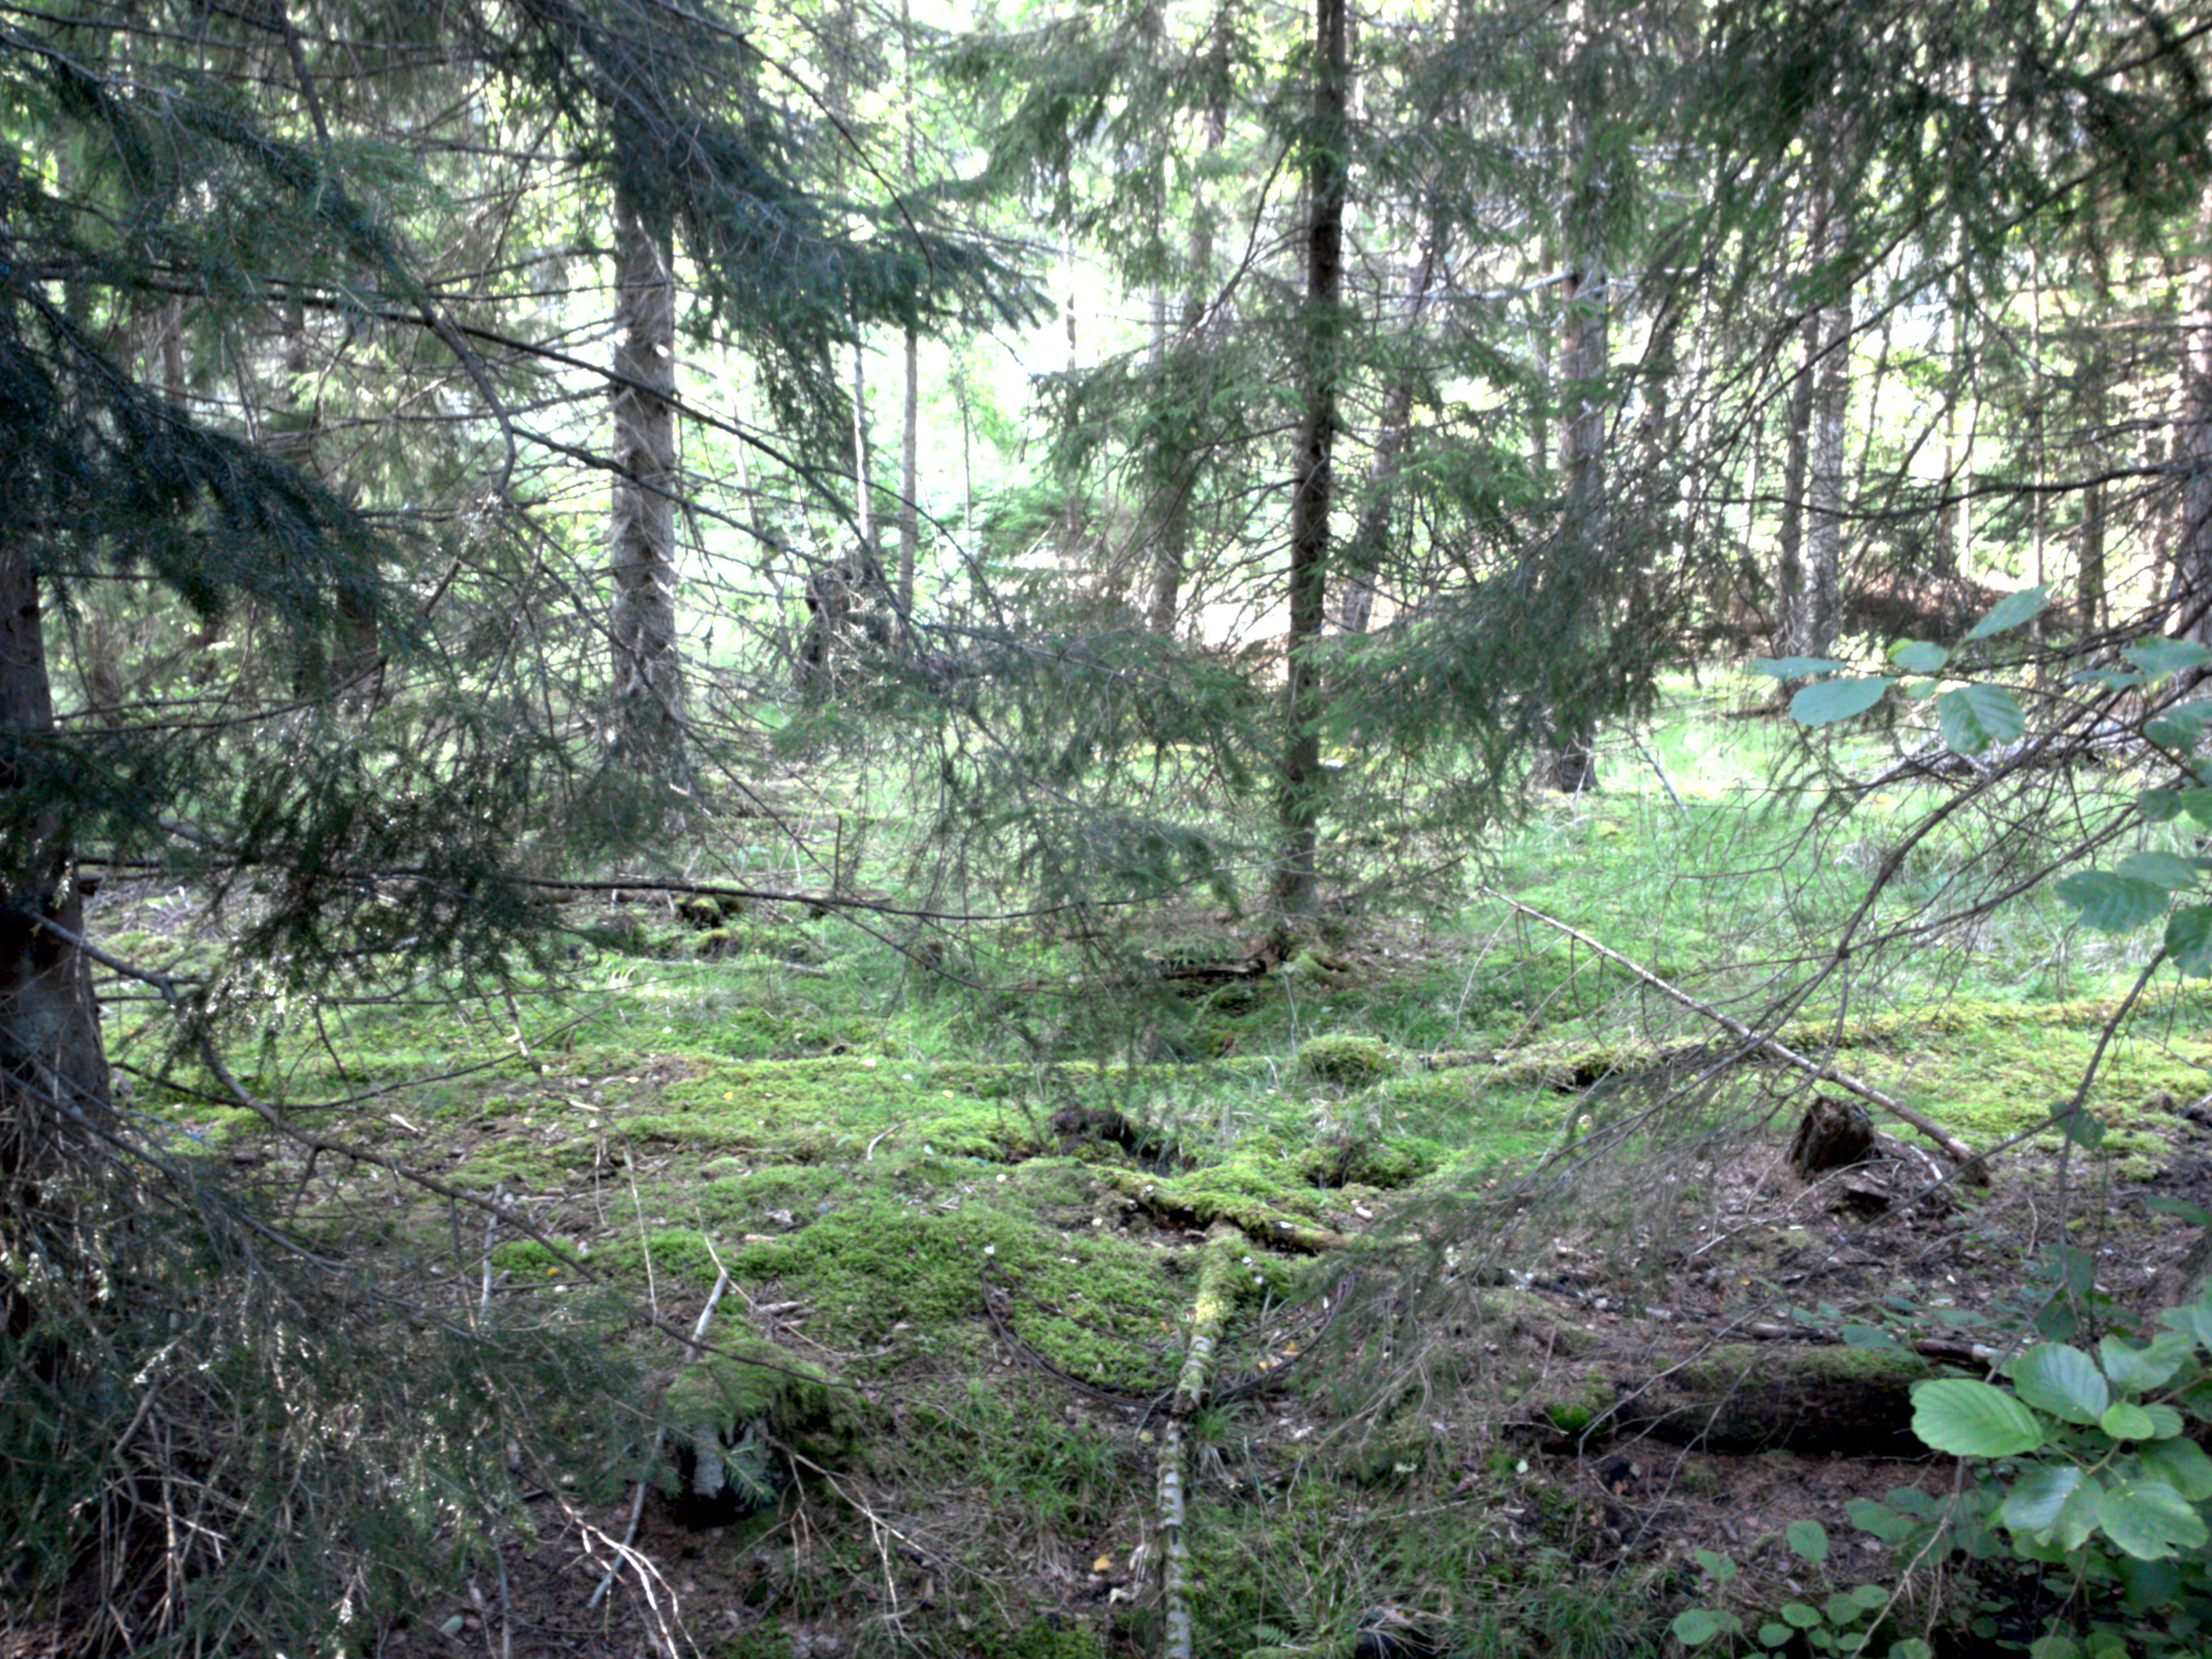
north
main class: Woodland
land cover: Spruce dominated coniferous woodland
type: boreal forest
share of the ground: > 75 %
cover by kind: coniferous forest trees 60 %, broadleaved forest trees 15 %, lichens and mosses 15 %, shrubs 10 %
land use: Forestry
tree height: > 5 m
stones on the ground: 10 - 25 %
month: July
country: SE
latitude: 59.0875
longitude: 18.2554
